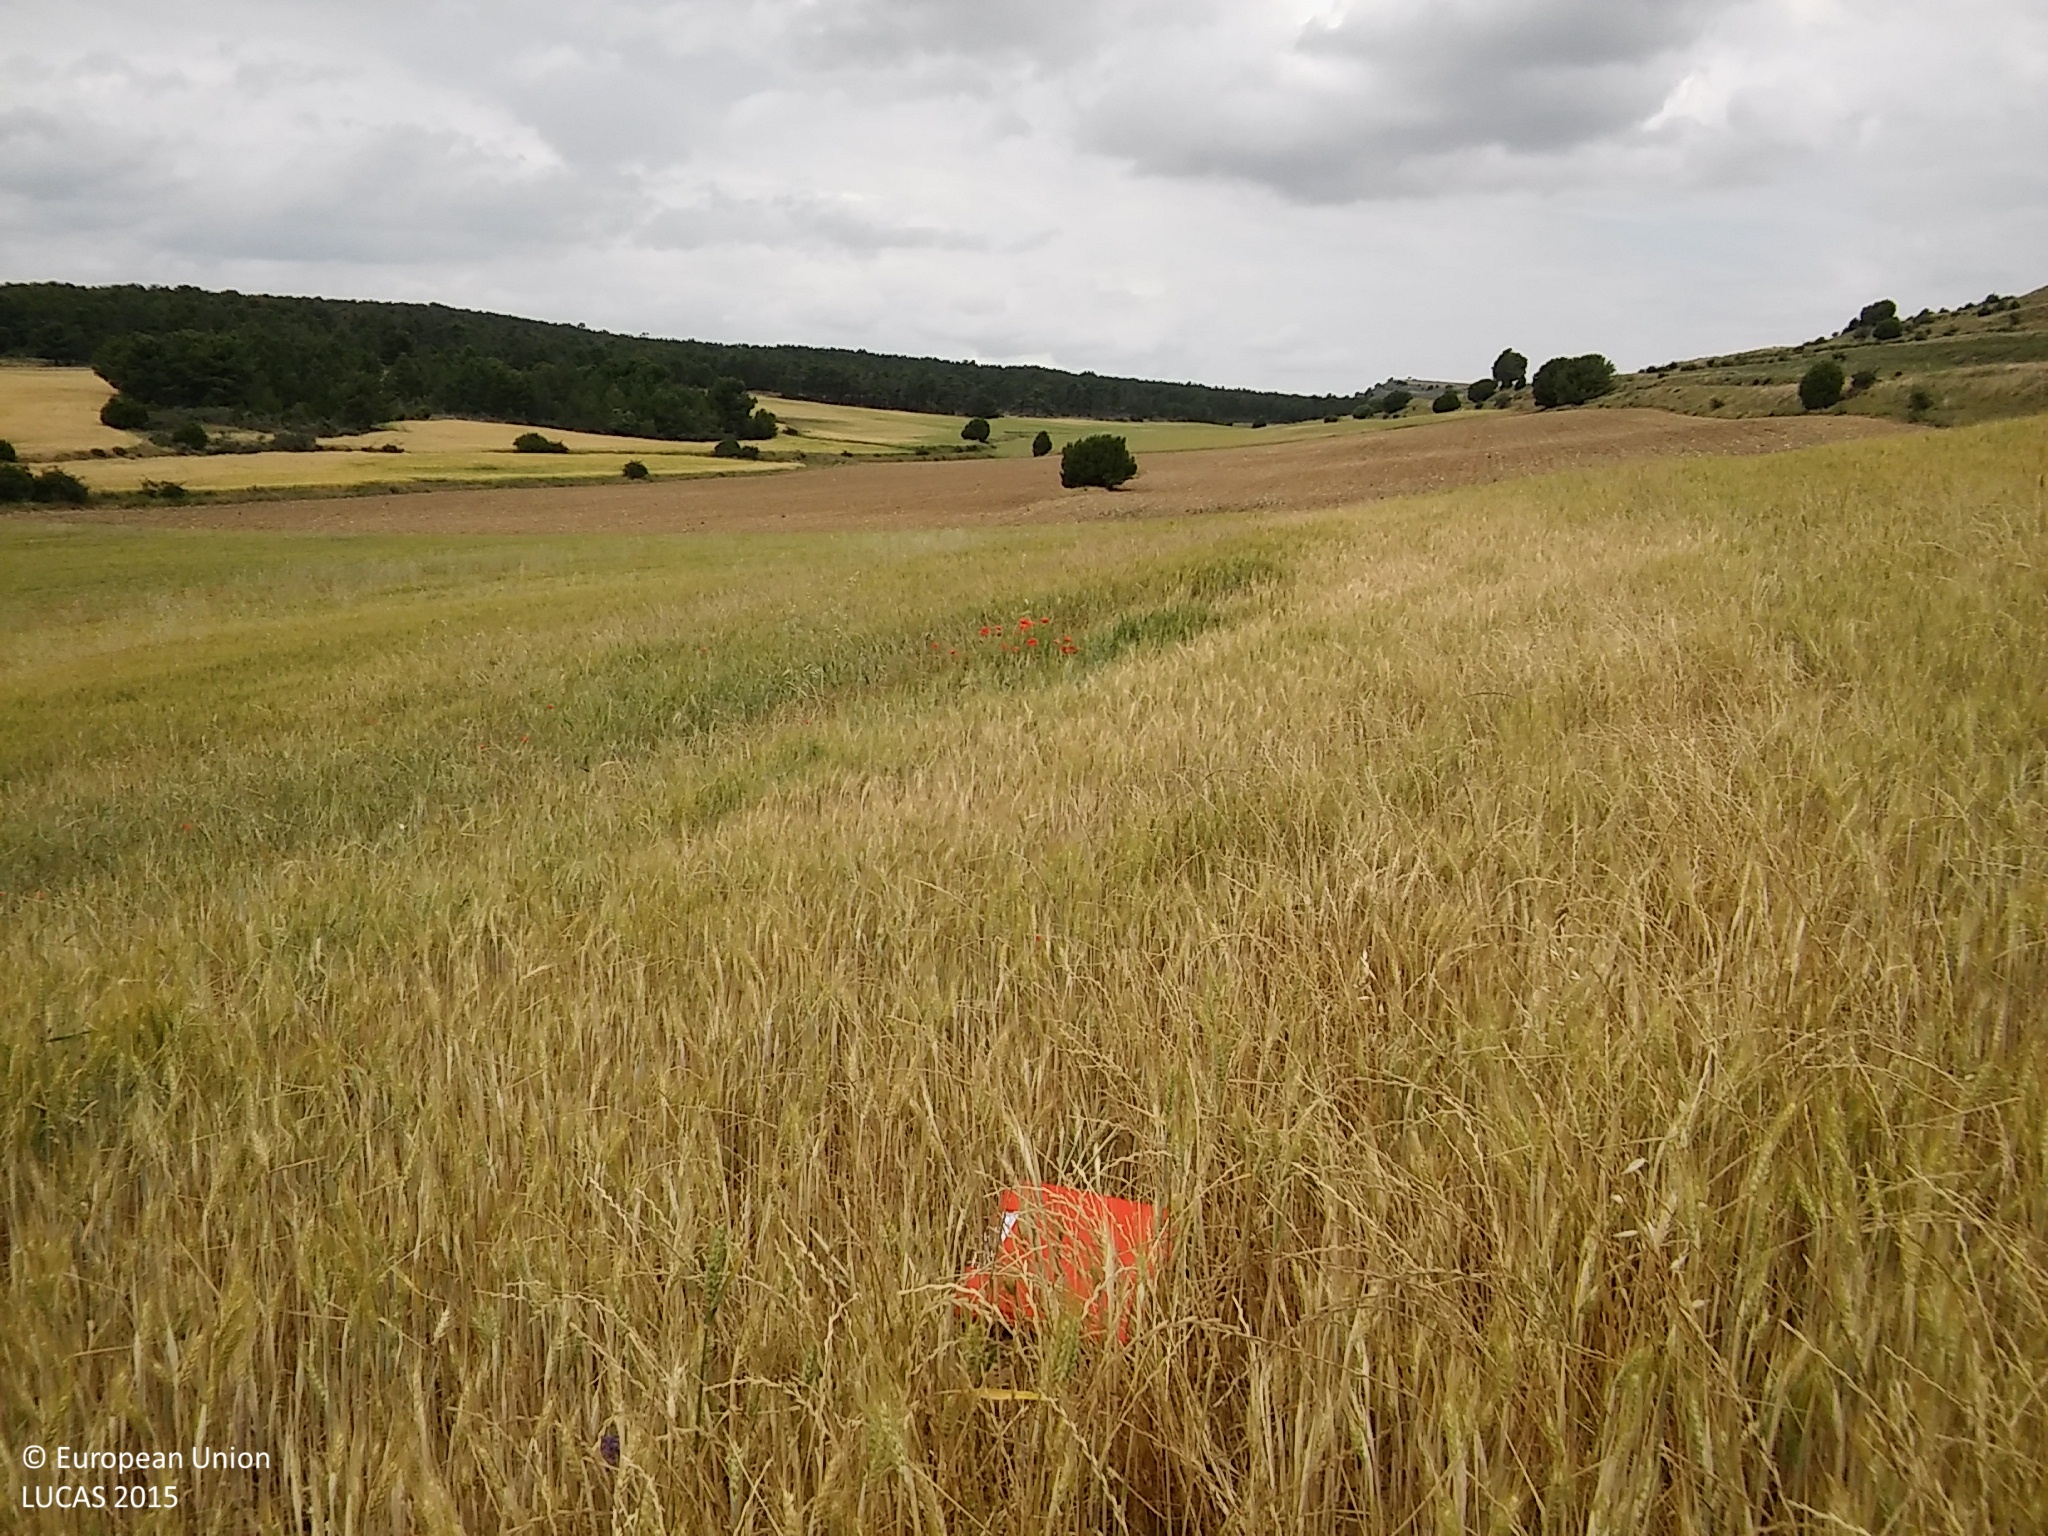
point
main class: Cropland
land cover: Common wheat
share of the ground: > 75 %
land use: Agriculture (excluding fallow land and kitchen gardens)
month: June
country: ES
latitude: 41.4913
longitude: -3.6206
